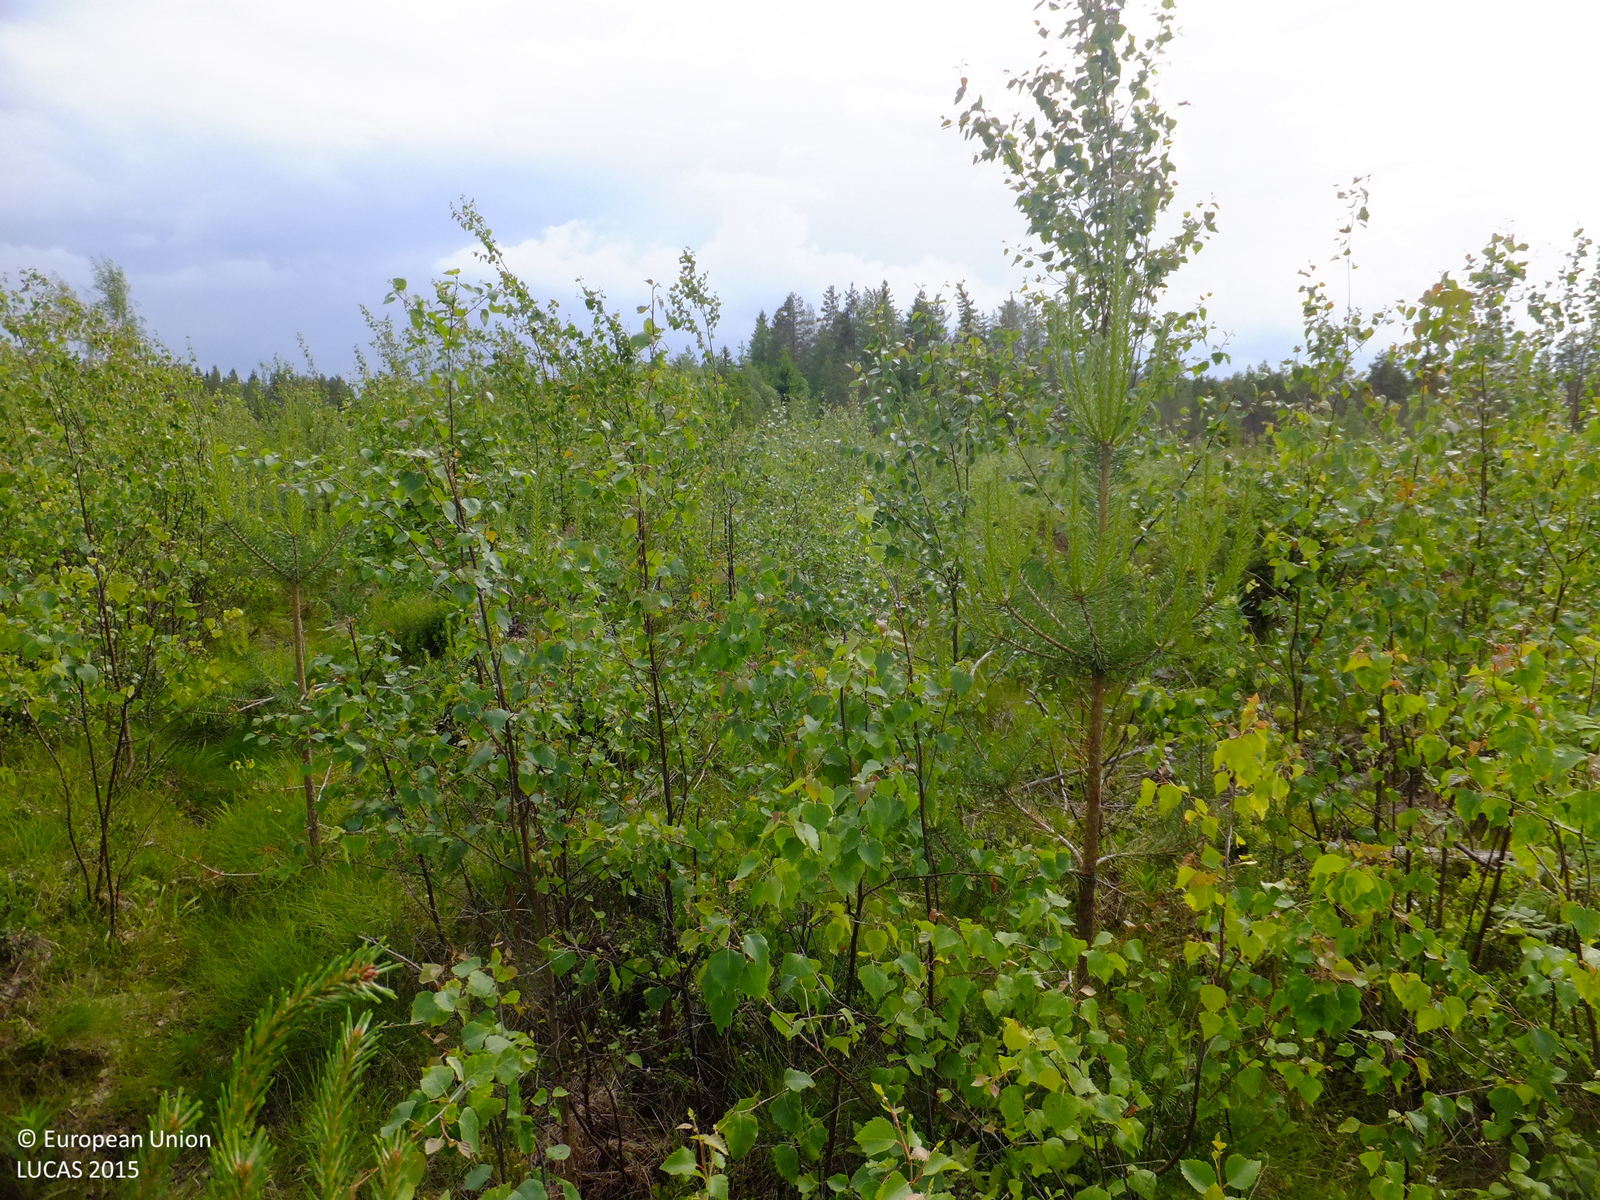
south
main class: Woodland
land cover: Pine dominated mixed woodland
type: boreal forest
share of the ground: 50 - 75 %
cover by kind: coniferous forest trees 30 %, broadleaved forest trees 30 %, herbaceous plants 20 %, shrubs 10 %, lichens and mosses 10 %
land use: Forestry
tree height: < 5 m
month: June
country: FI
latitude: 63.2448
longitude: 23.9497
